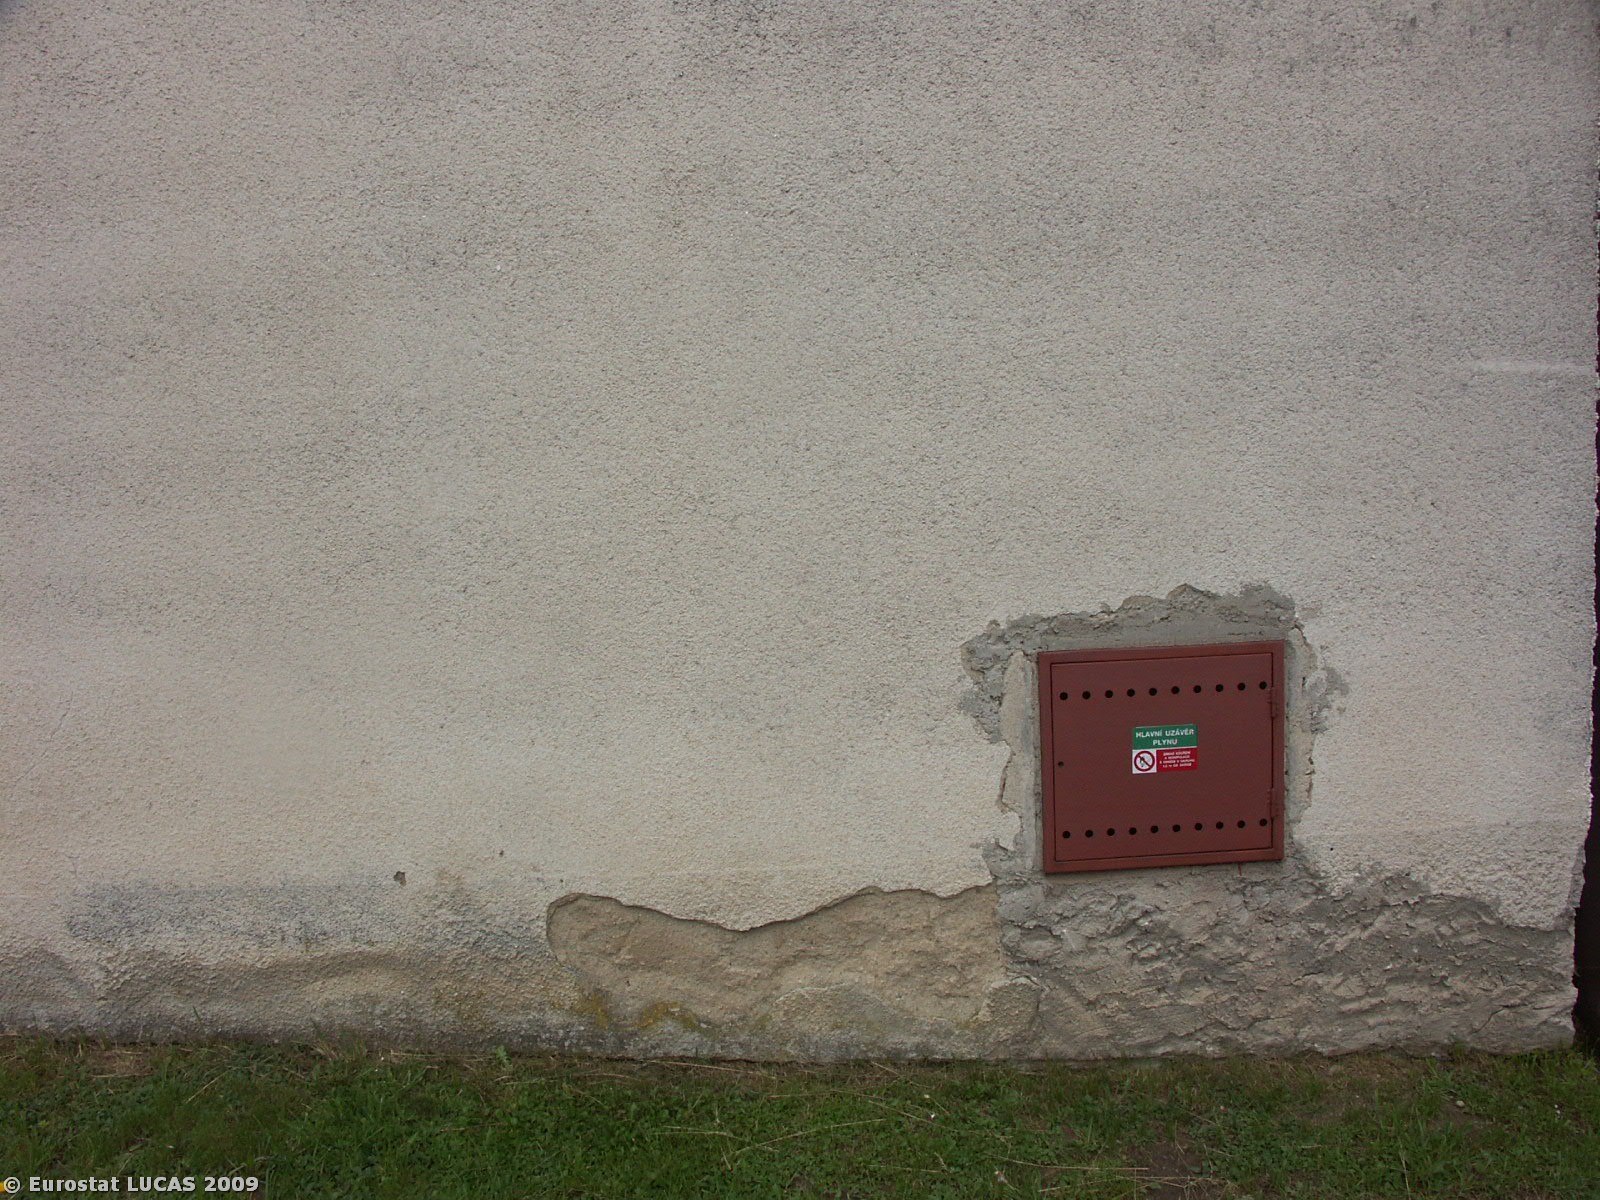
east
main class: Cropland
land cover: Cherry fruit
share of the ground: 50 - 75 %
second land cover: Grassland with sparse tree/shrub cover
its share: > 75 %
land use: Kitchen garden
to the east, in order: Cherry fruit; Grassland with sparse tree/shrub cover; Artificial constructions in urban areas
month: May
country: CZ
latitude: 49.1577
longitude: 14.9523
